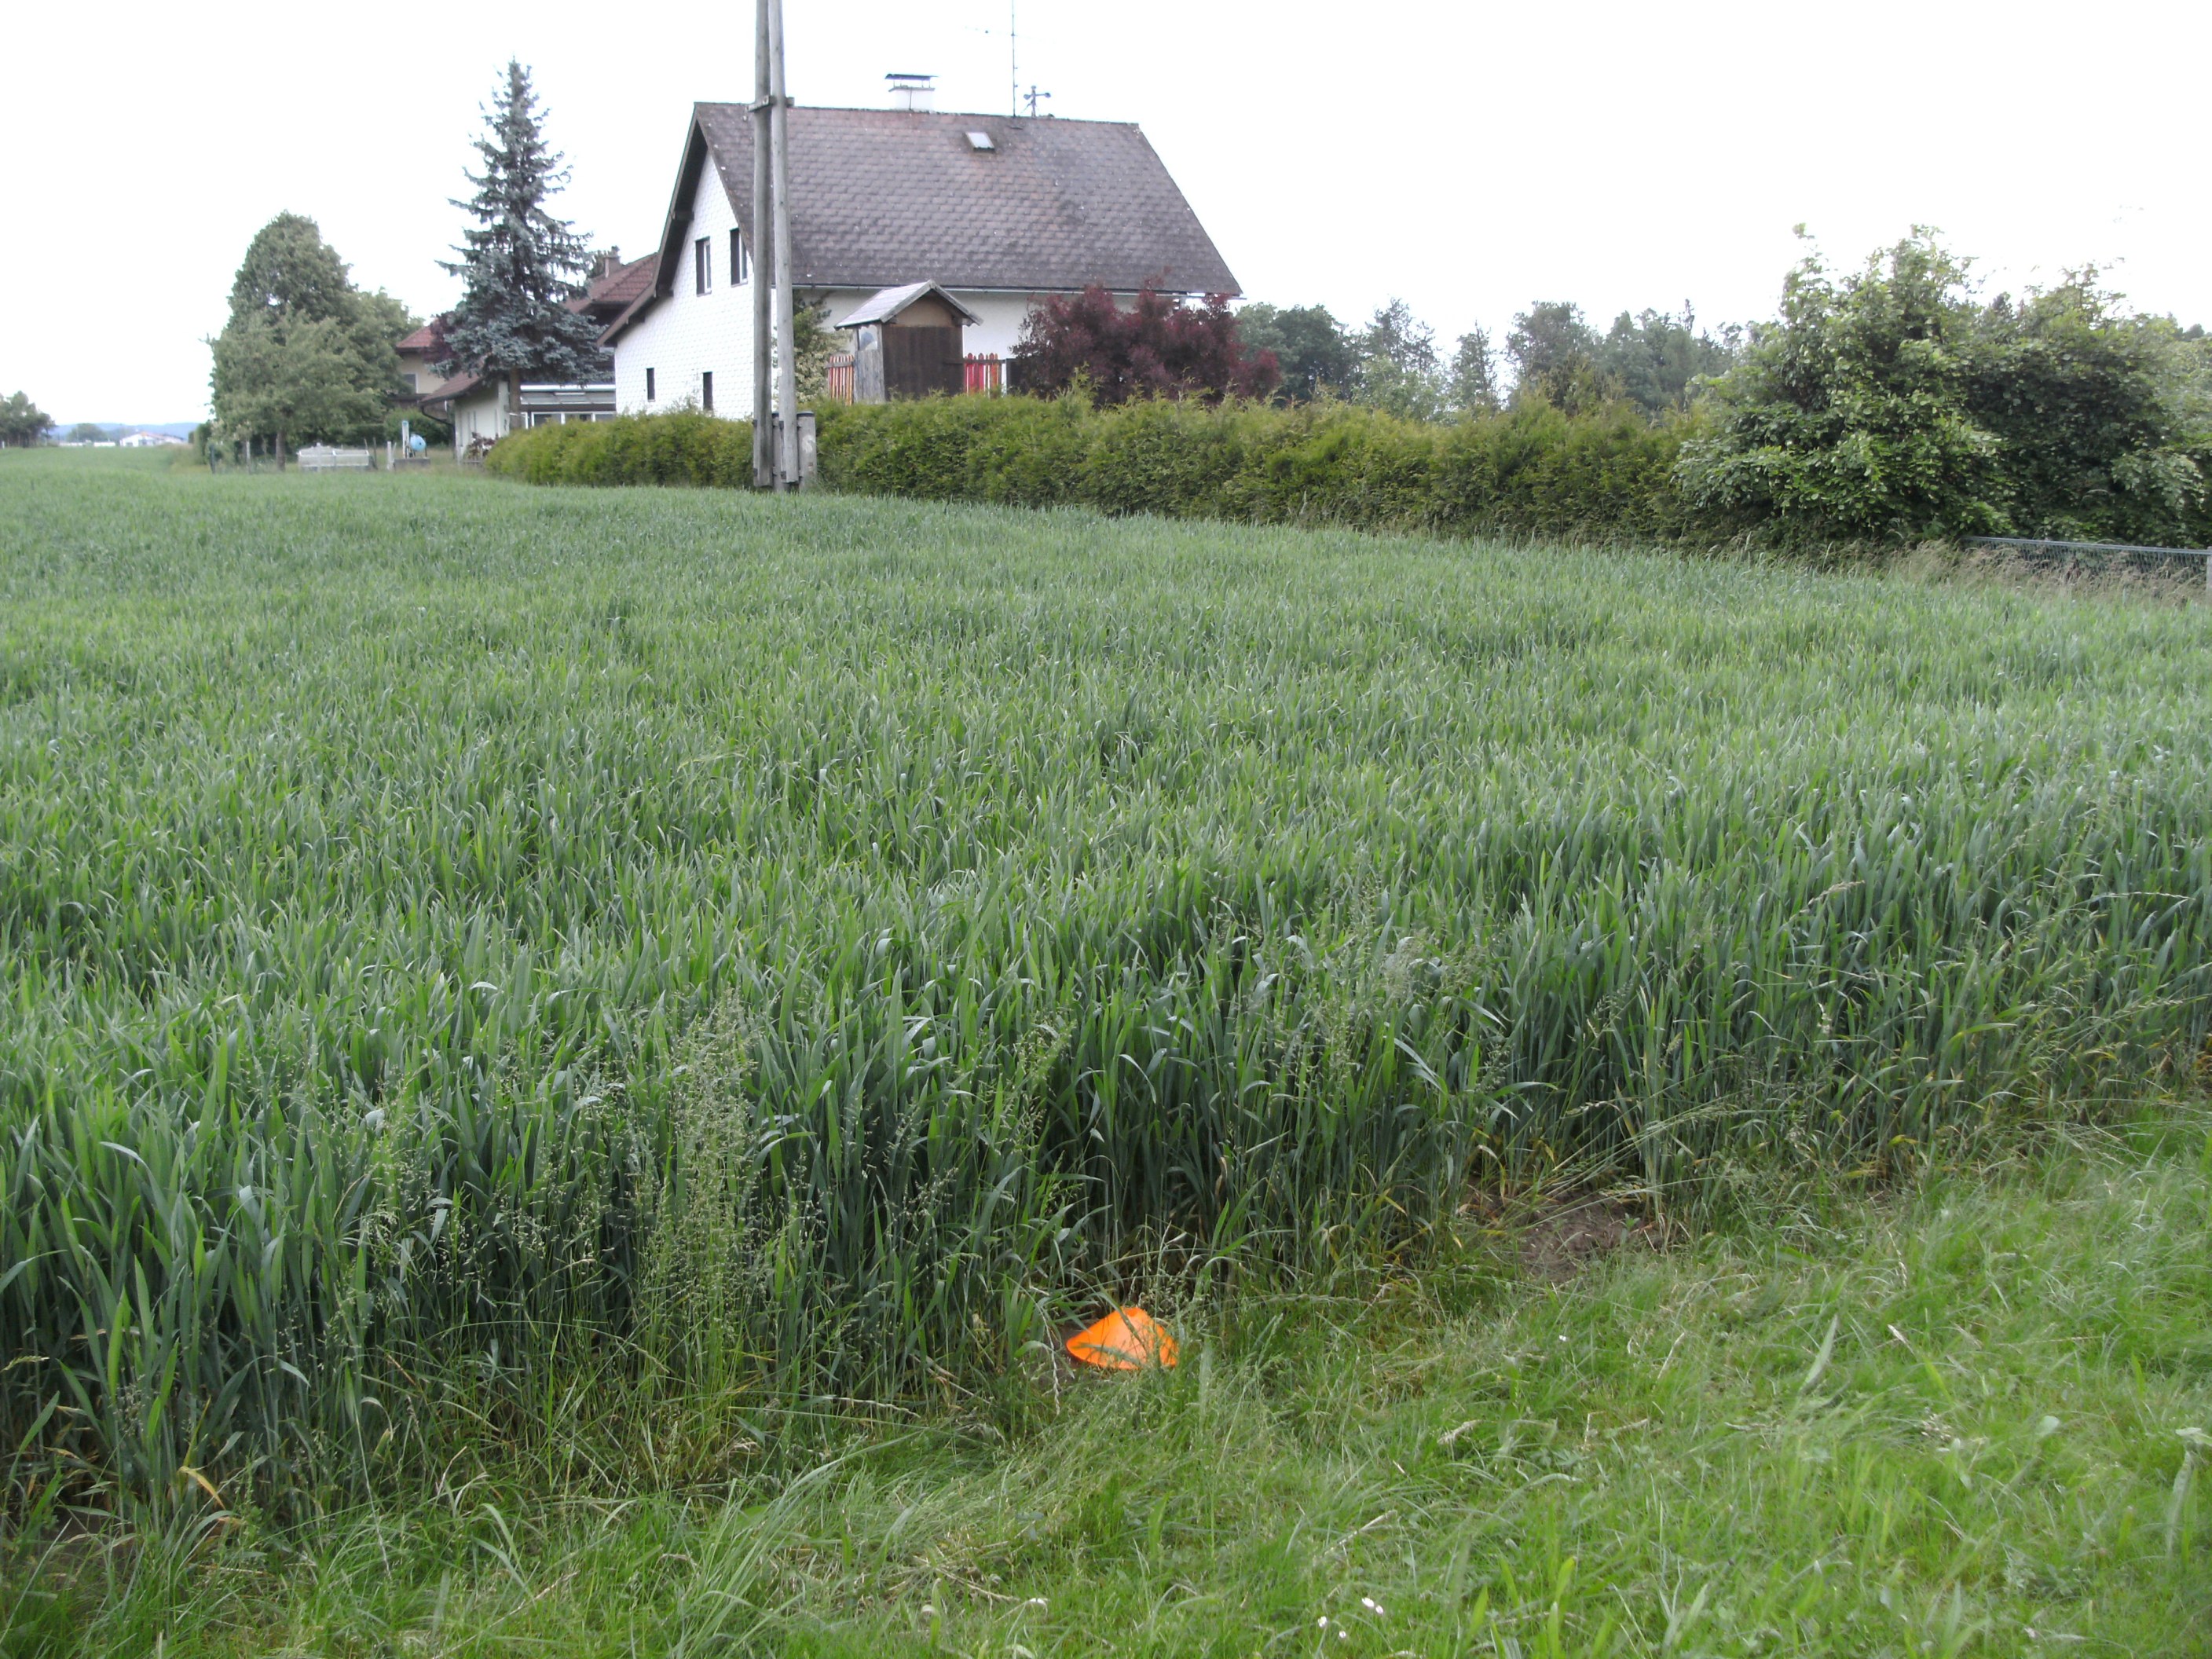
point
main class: Cropland
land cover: Common wheat
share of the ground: > 75 %
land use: Agriculture (excluding fallow land and kitchen gardens)
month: May
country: AT
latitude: 48.0142
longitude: 13.7932
